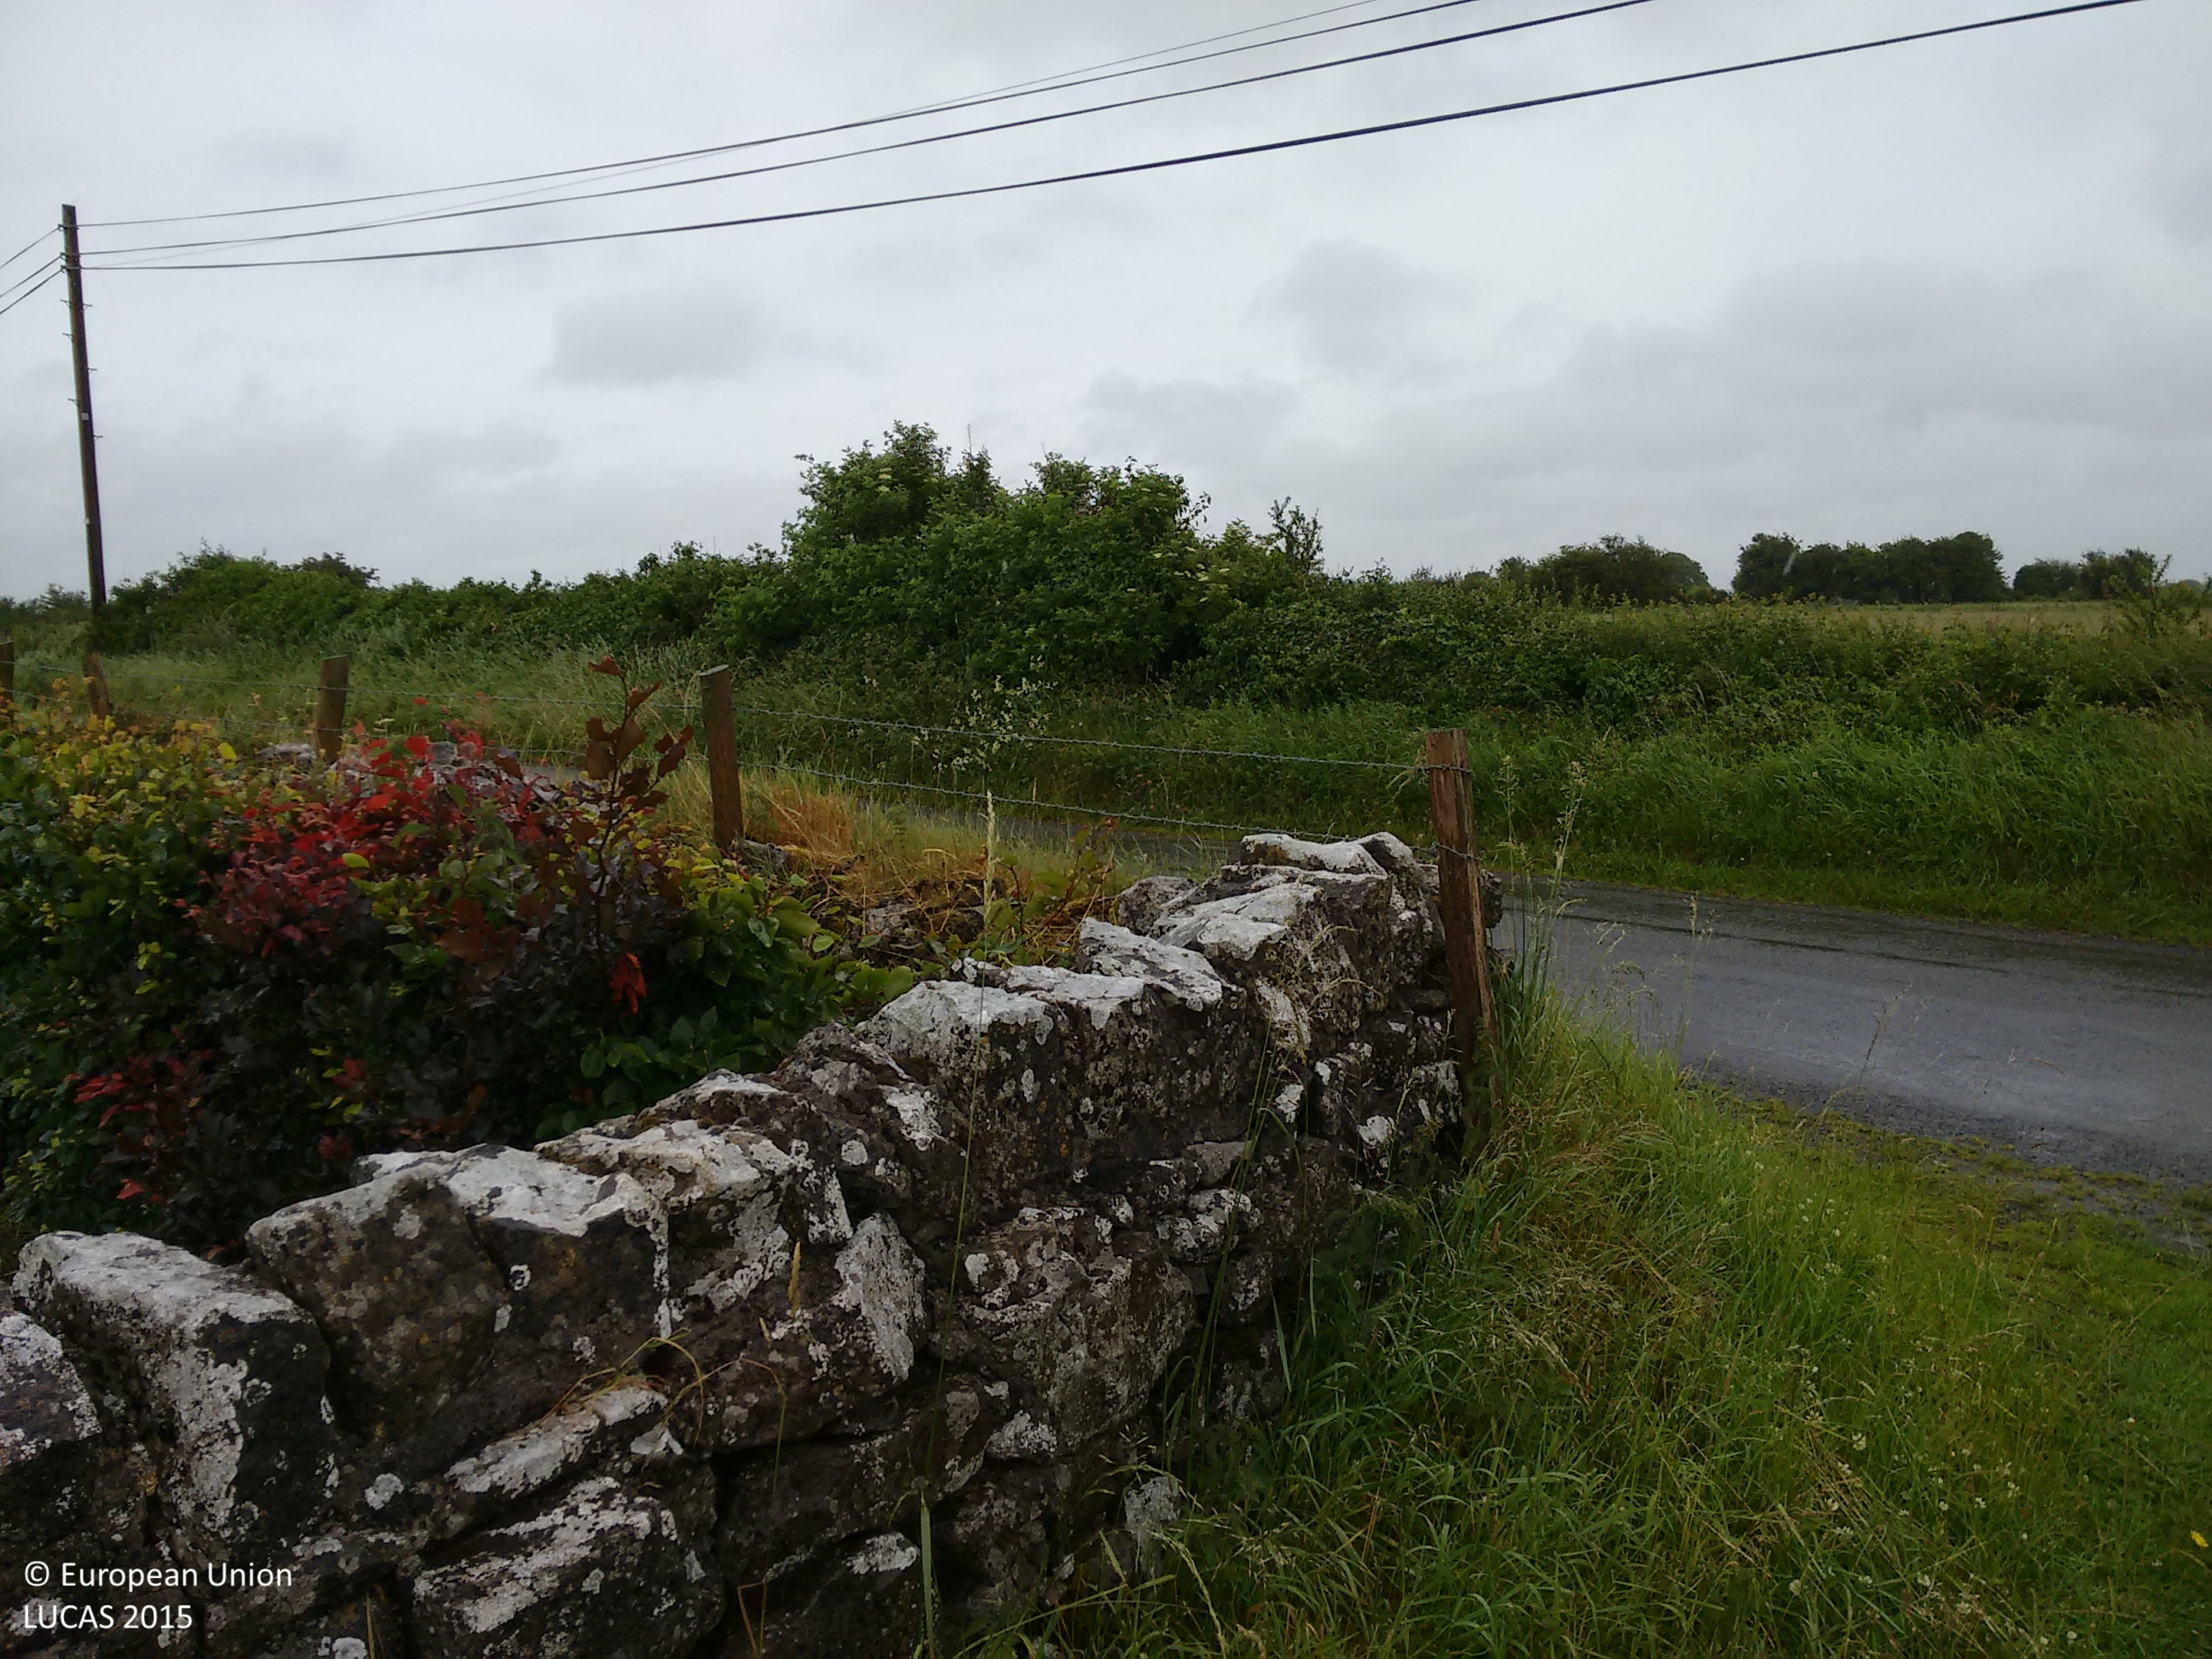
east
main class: Grassland
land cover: Grassland without tree/shrub cover
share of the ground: > 75 %
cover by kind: herbaceous plants 100 %
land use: Agriculture (excluding fallow land and kitchen gardens)
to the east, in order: Grassland without tree/shrub cover; Artificial constructions in urban areas; Grass margins; Electric lines; Broadleaved woodland; Grassland with sparse tree/shrub cover; Grassland without tree/shrub cover
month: July
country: IE
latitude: 53.5928
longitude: -8.0814
